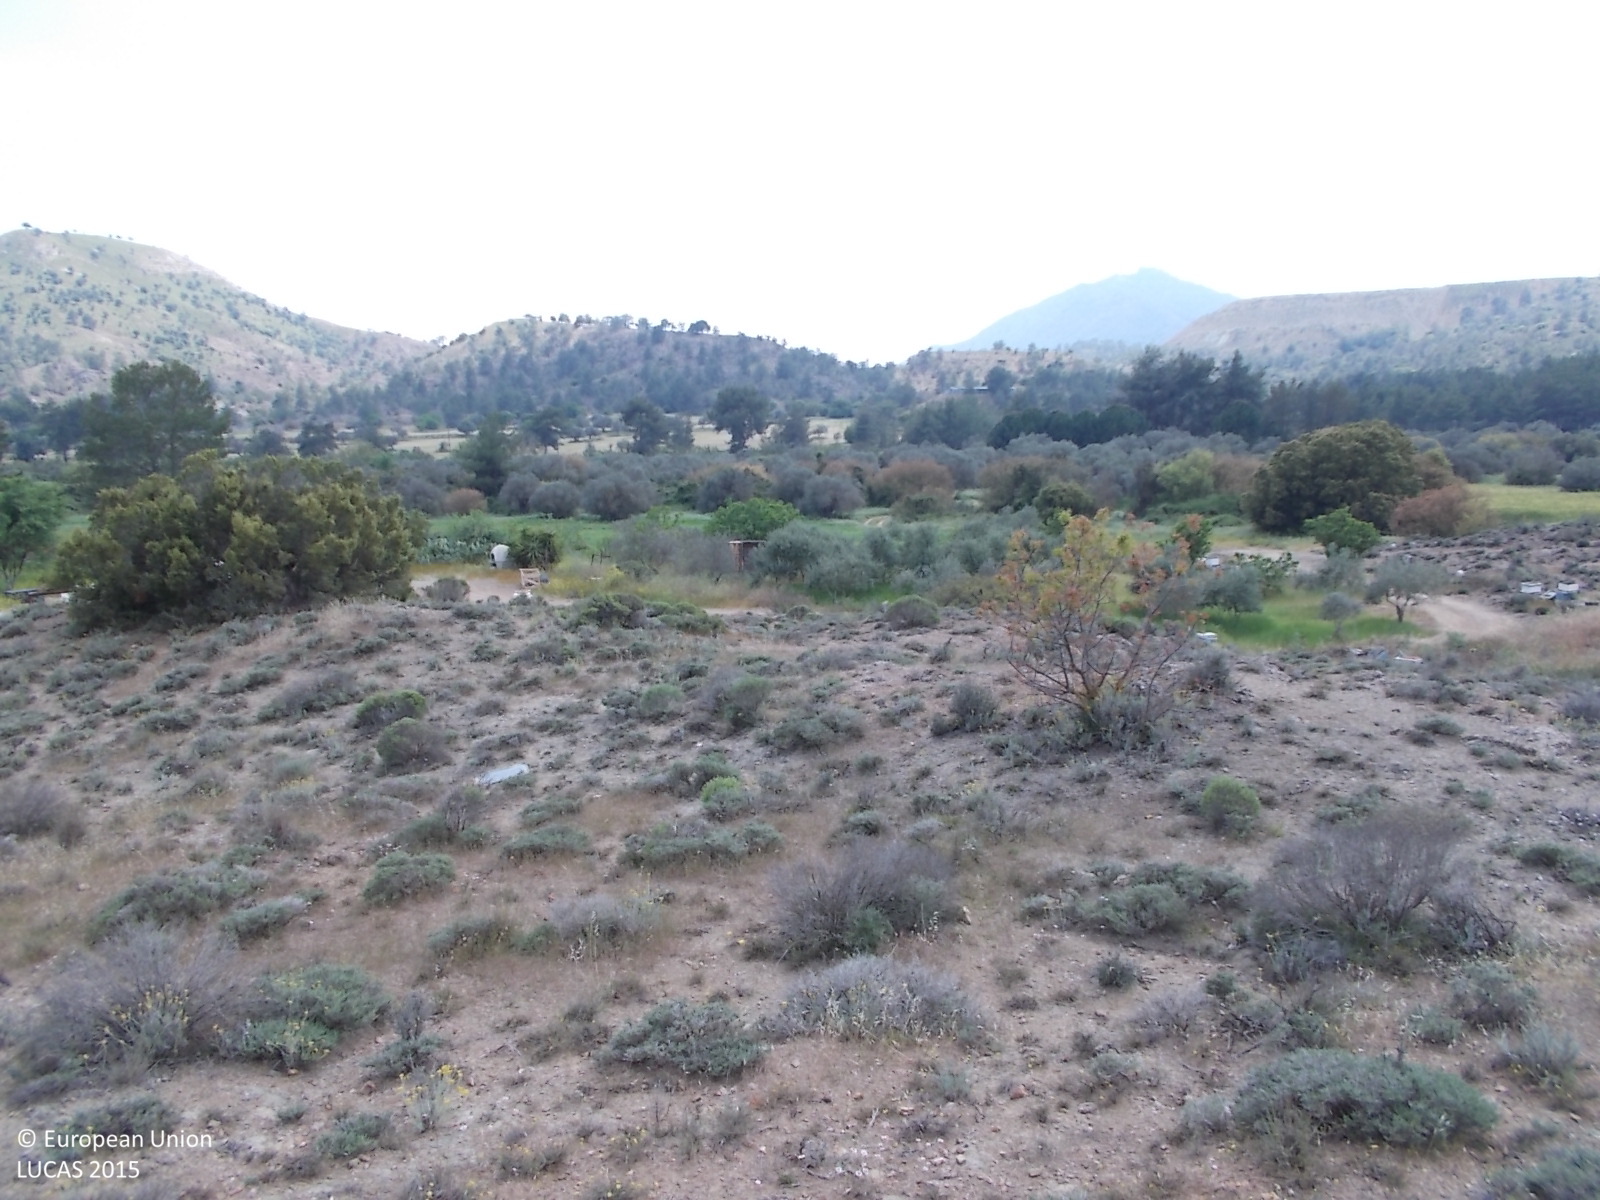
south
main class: Shrubland
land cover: Shrubland without tree cover
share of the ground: 25 - 50 %
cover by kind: unconsolidated bare surface 50 %, shrubs 45 %, consolidated bare surface 5 %
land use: Semi-natural and natural areas not in use
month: April
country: CY
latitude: 34.9217
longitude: 33.4502
